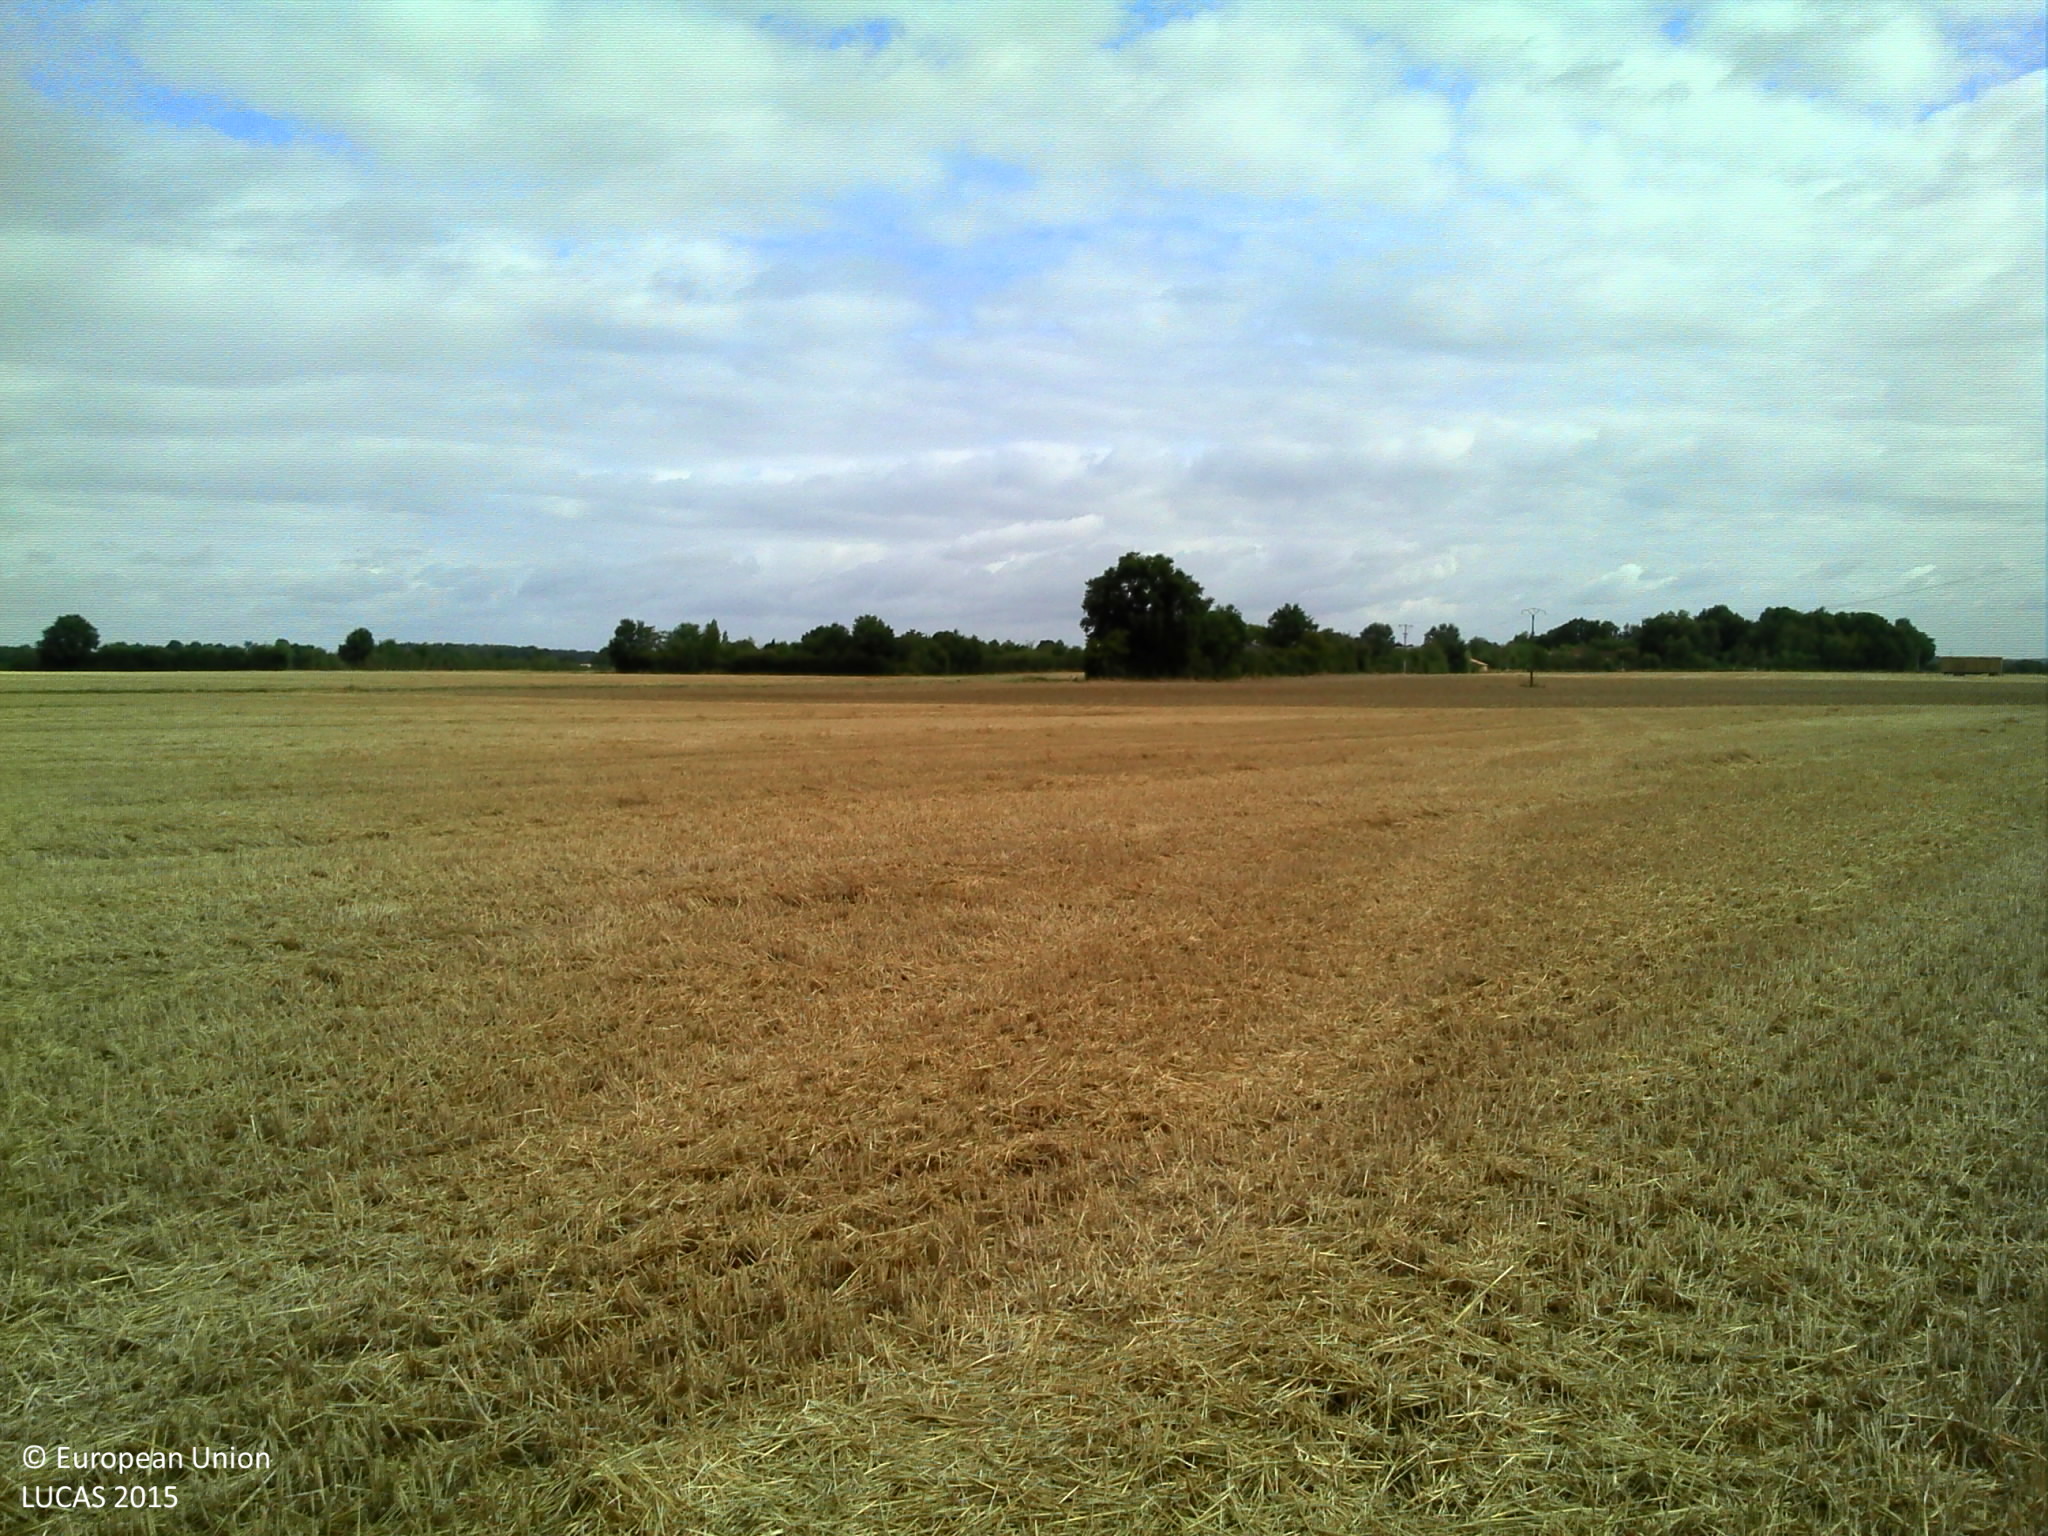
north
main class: Cropland
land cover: Common wheat
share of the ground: > 75 %
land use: Agriculture (excluding fallow land and kitchen gardens)
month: July
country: FR
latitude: 46.3471
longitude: 0.3273
